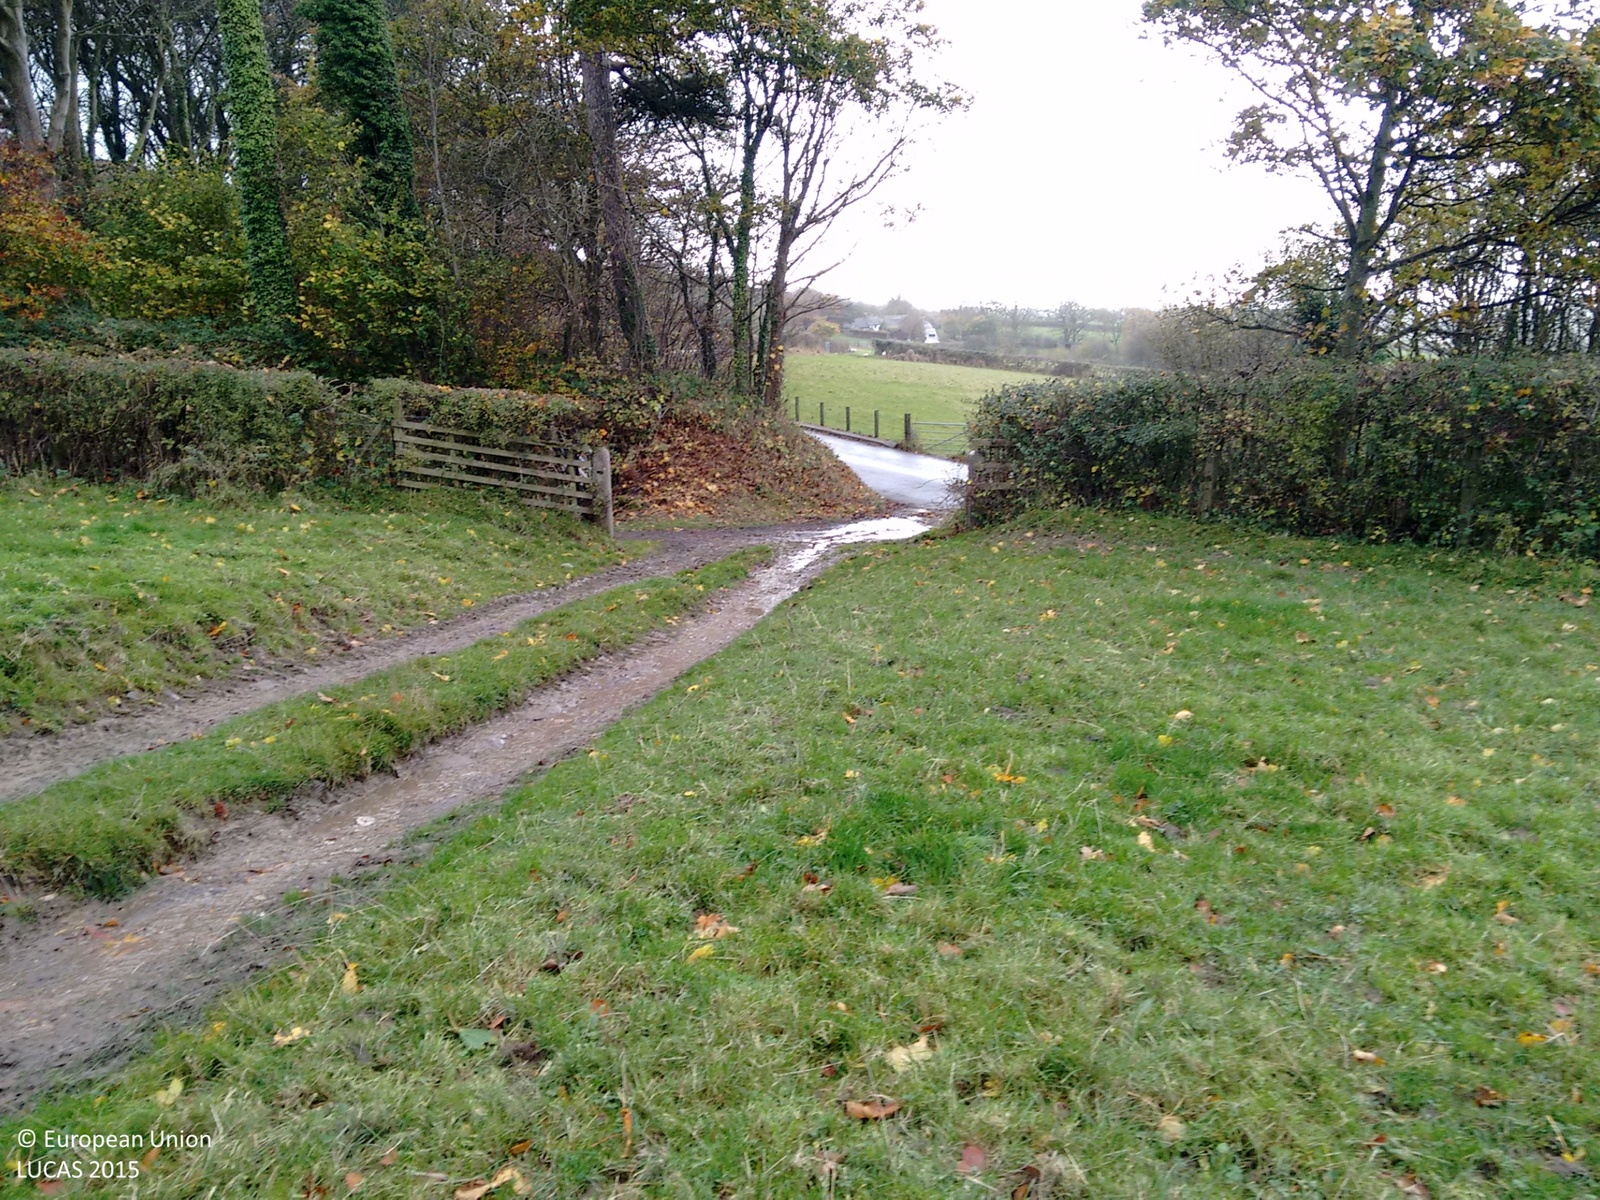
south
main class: Grassland
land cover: Grassland without tree/shrub cover
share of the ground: > 75 %
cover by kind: herbaceous plants 100 %
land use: Agriculture (excluding fallow land and kitchen gardens)
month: November
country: GB
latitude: 54.2083
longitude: -3.1856
